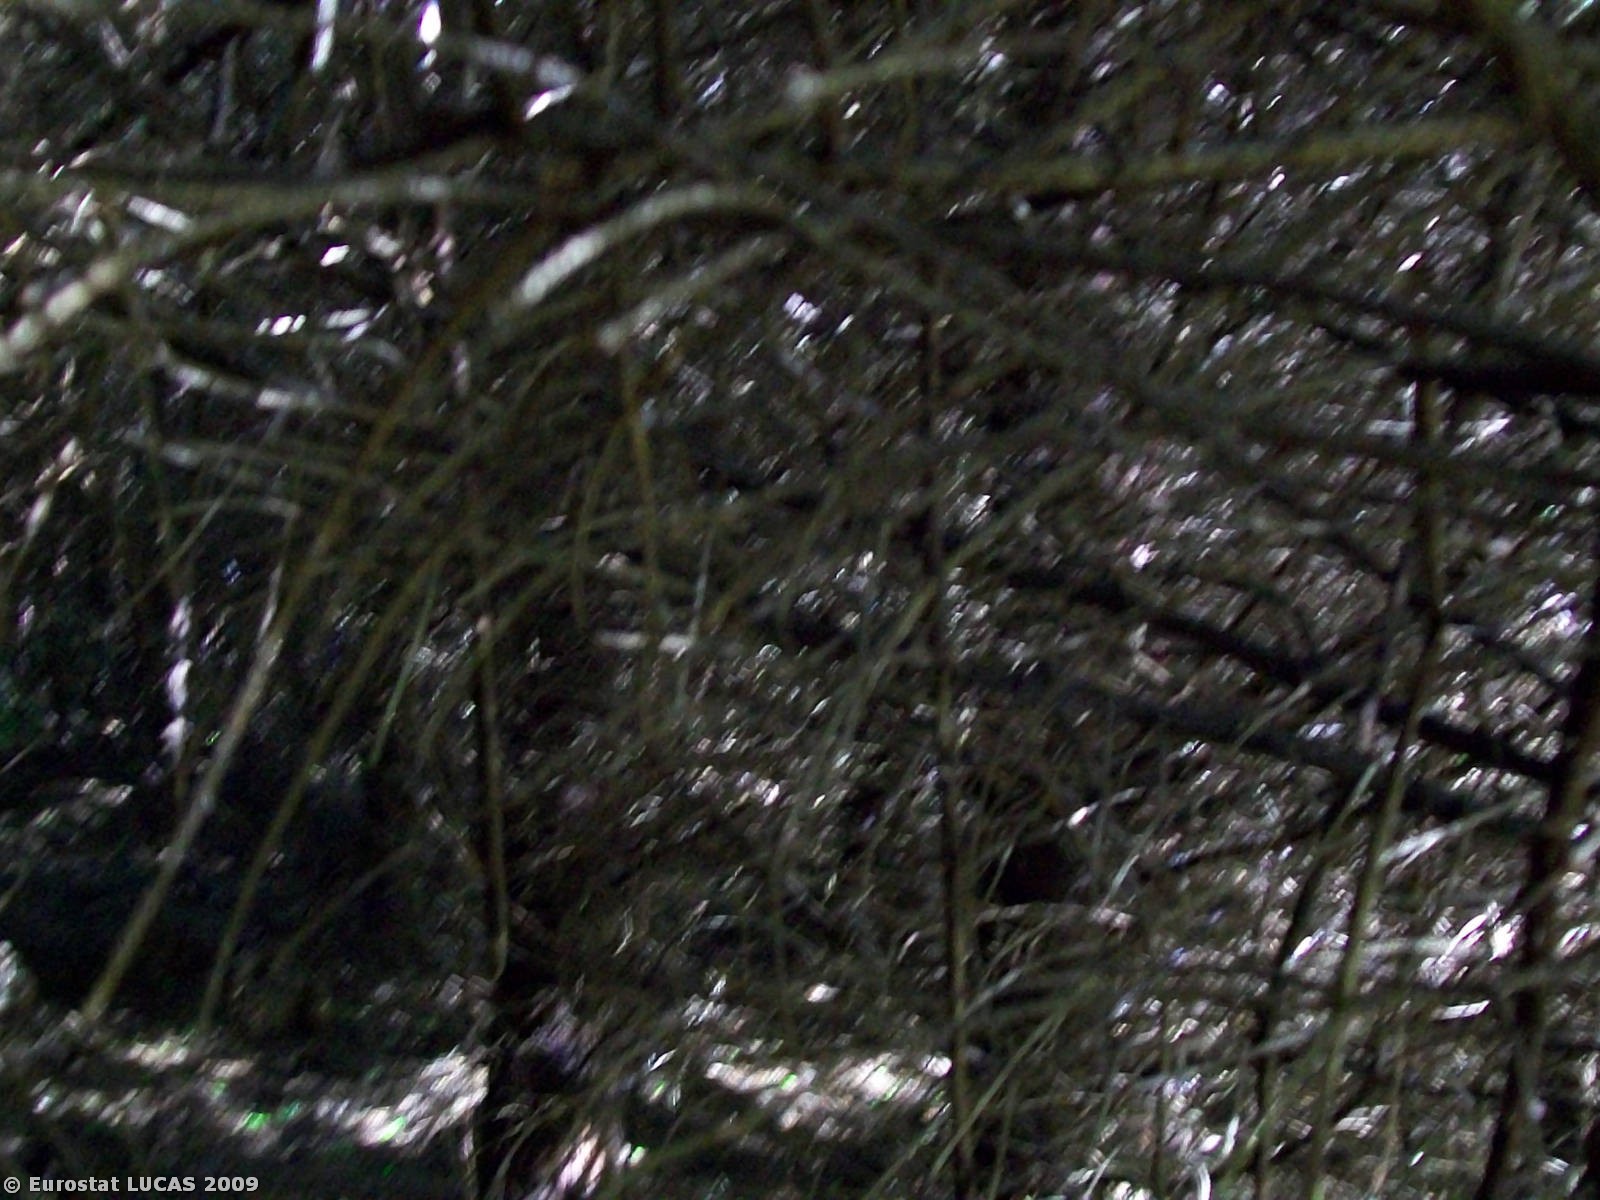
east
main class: Woodland
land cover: Coniferous woodland
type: plantations and self-sown exotic forest
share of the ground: > 75 %
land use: Forestry
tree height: > 5 m
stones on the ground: < 10 %
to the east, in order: Coniferous woodland
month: May
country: IE
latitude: 51.8356
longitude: -8.7957
